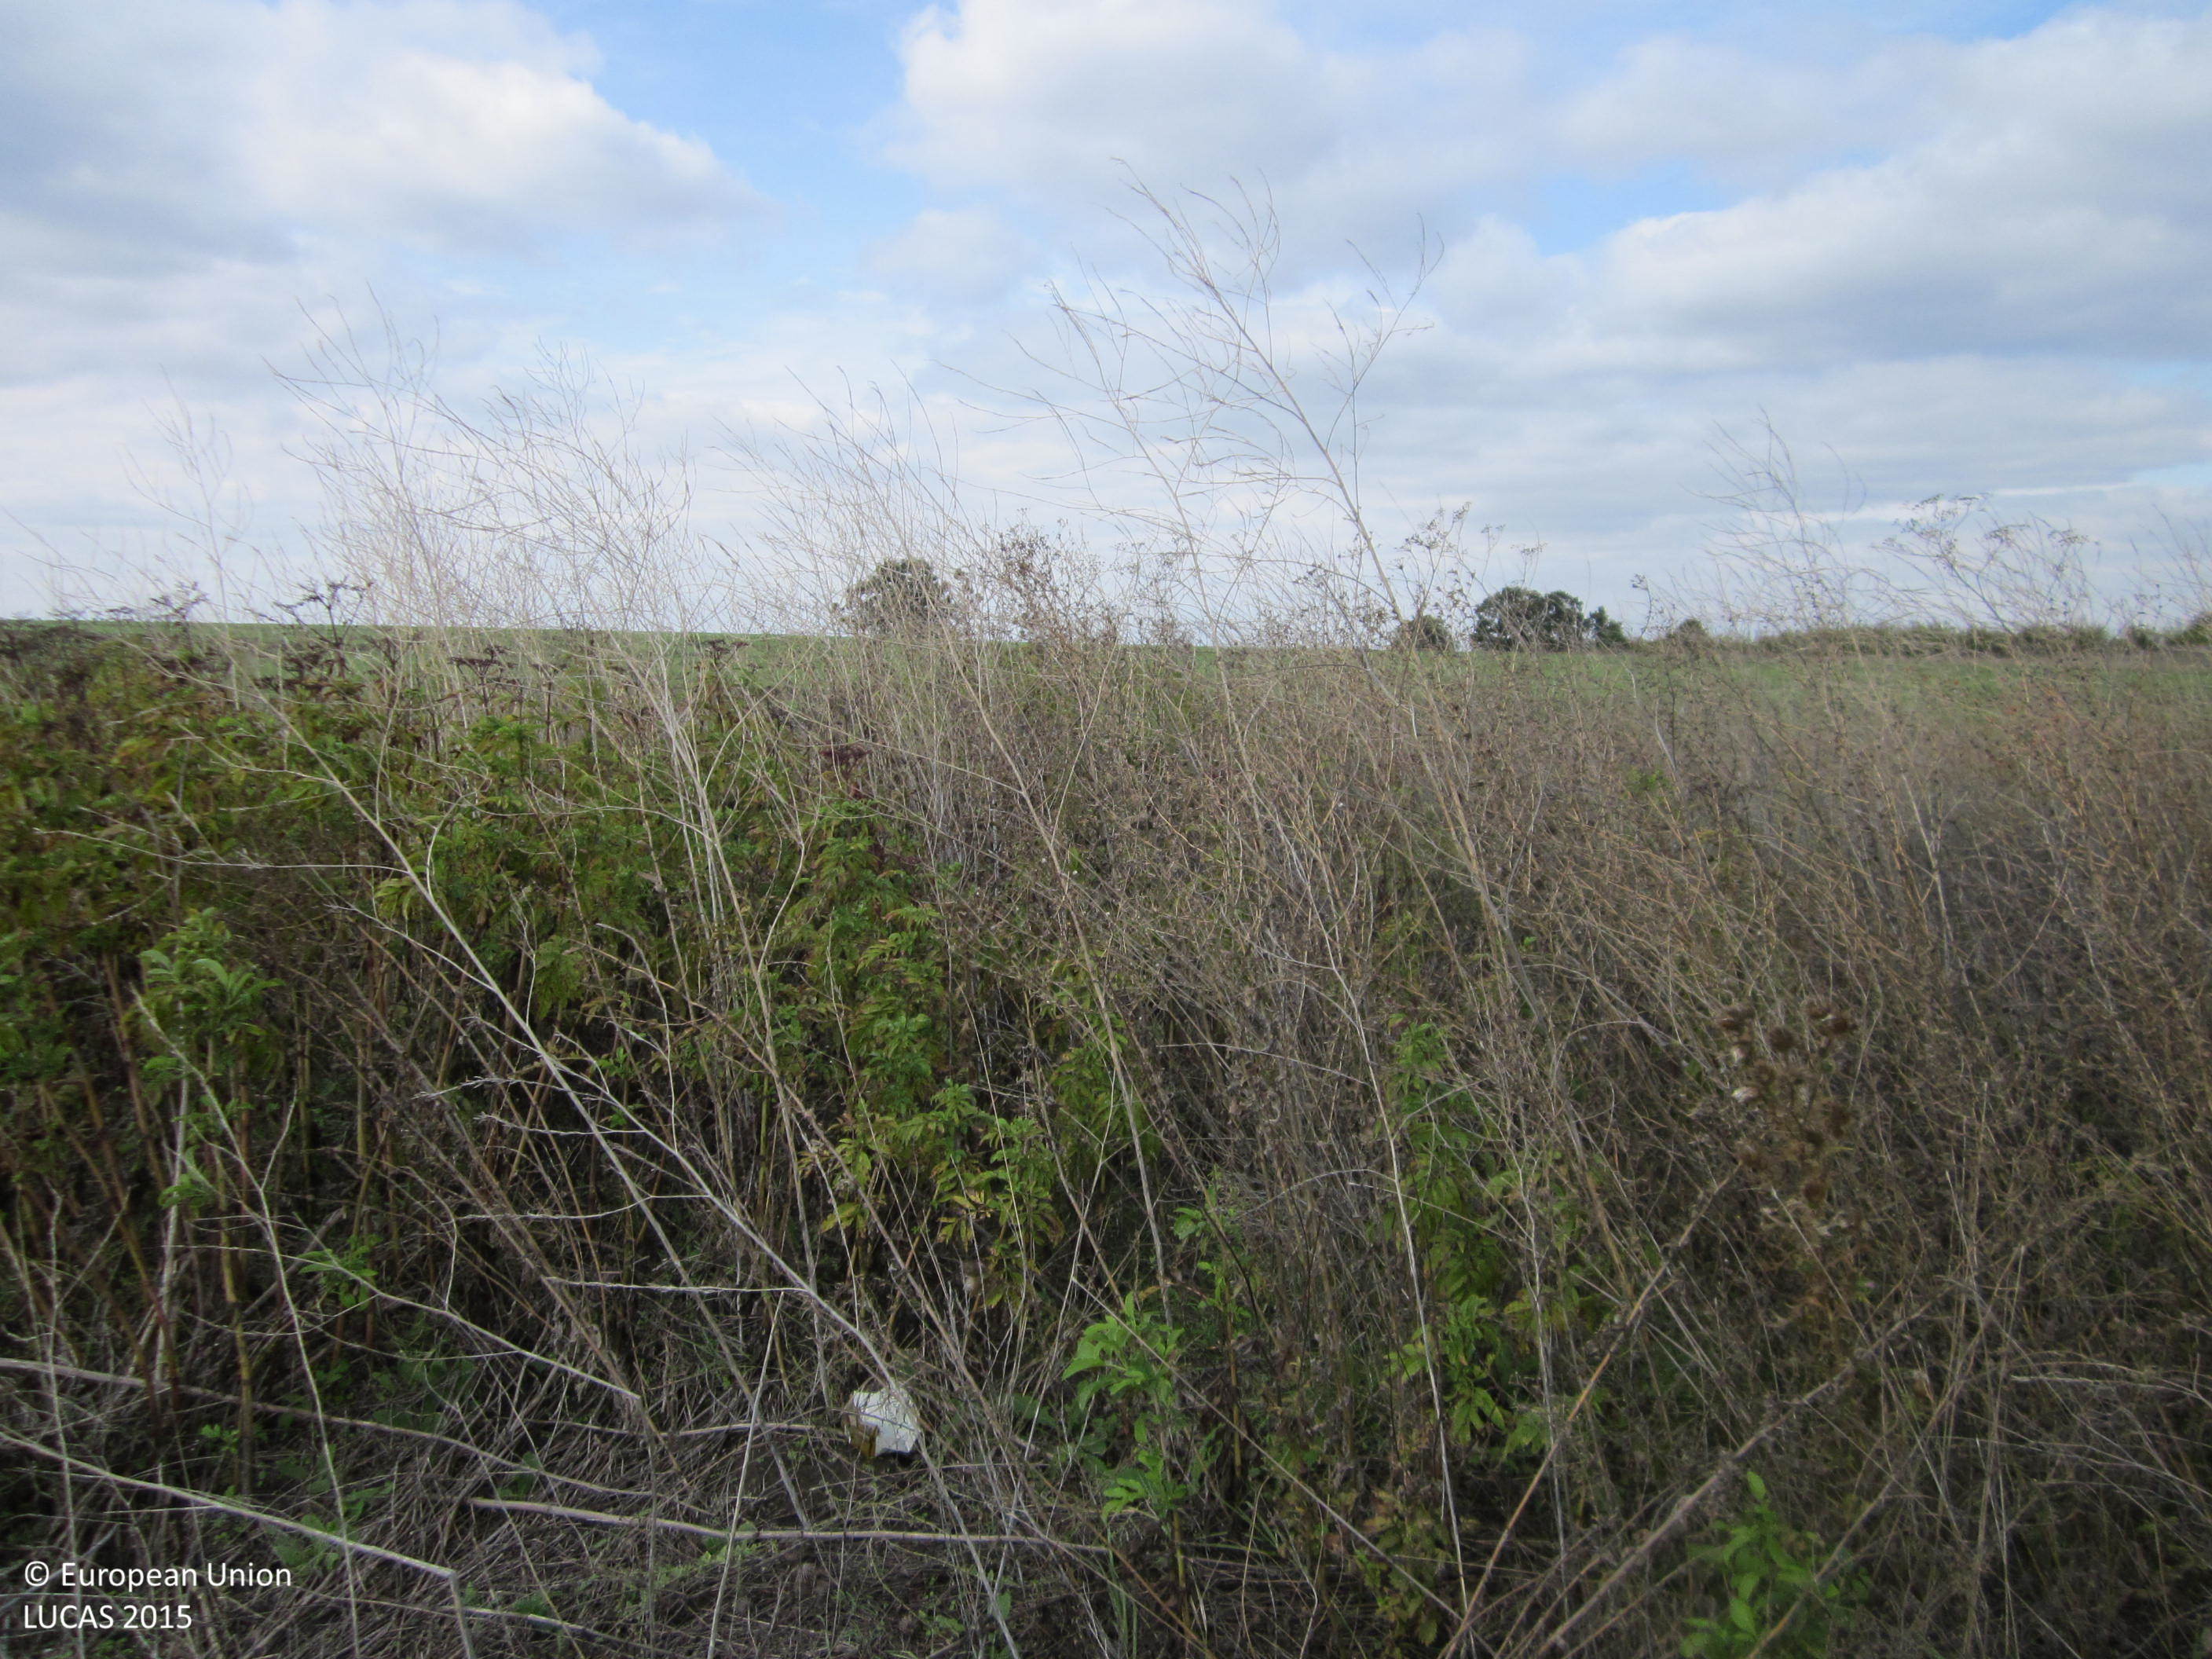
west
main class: Grassland
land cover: Spontaneously vegetated surfaces
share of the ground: > 75 %
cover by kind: herbaceous plants 100 %
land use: Fallow land
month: October
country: BG
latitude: 42.3442
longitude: 27.0117
